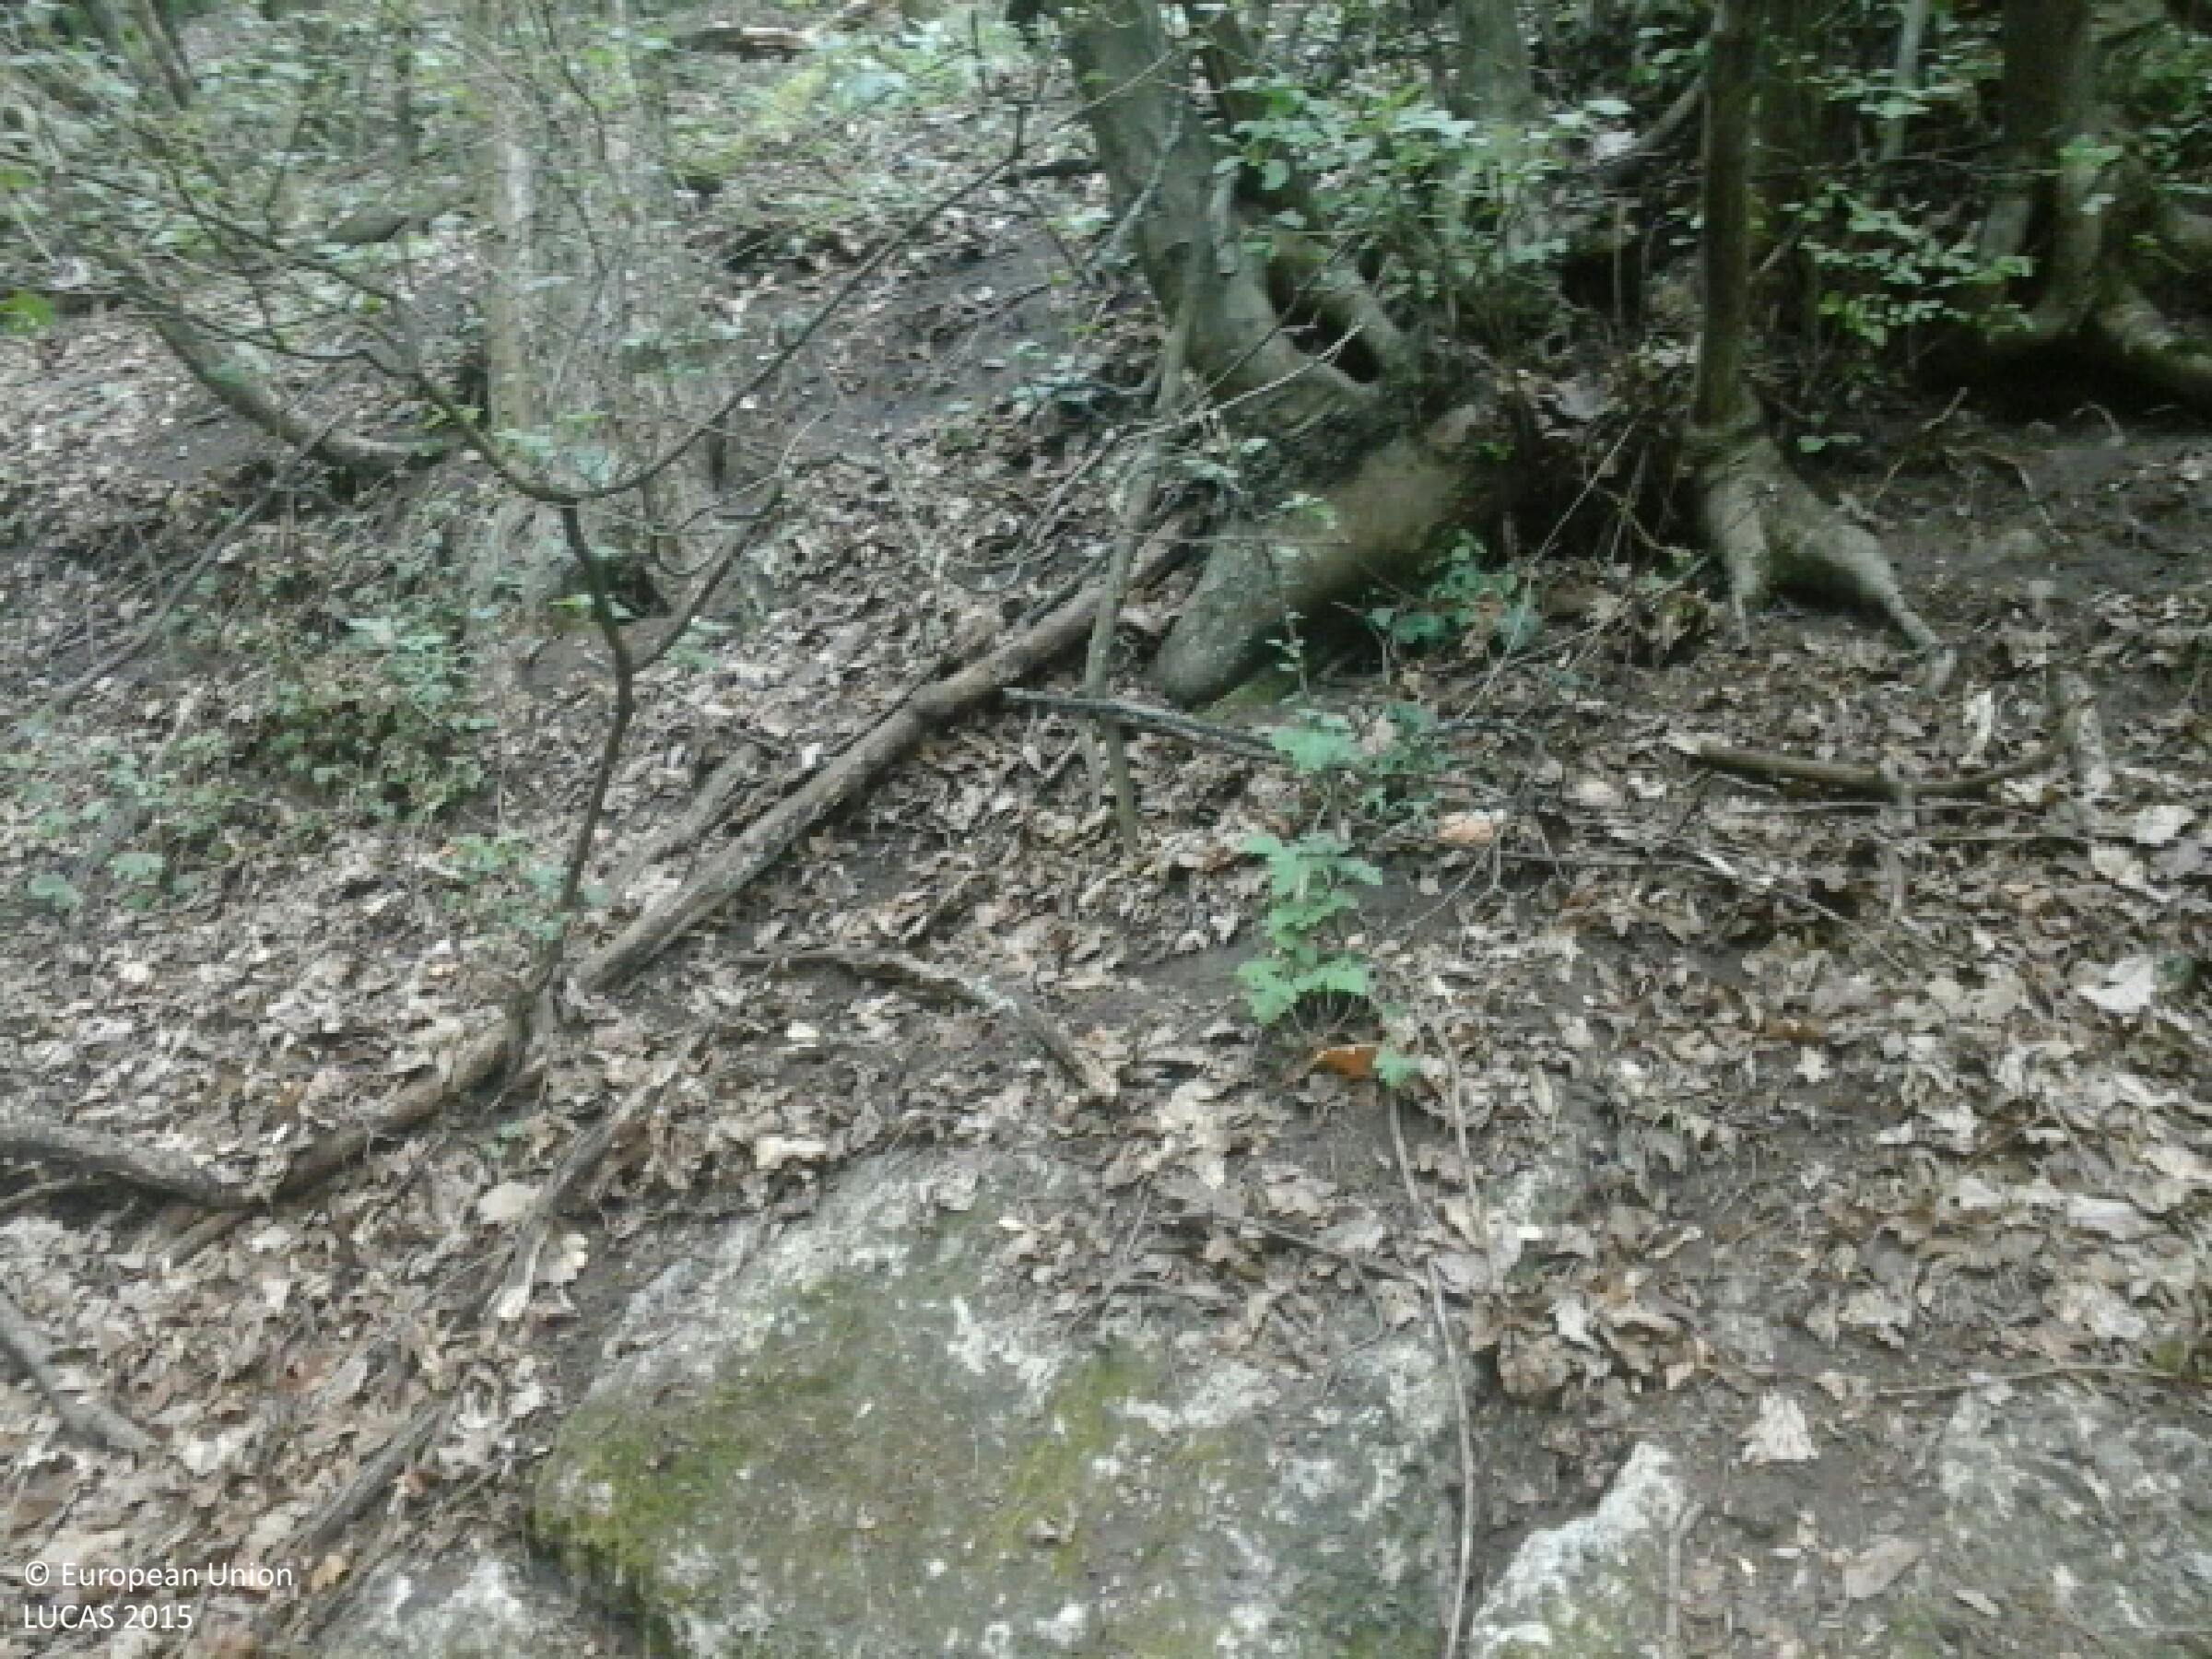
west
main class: Woodland
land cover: Broadleaved woodland
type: mesophytic deciduous forest
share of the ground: > 75 %
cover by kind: broadleaved forest trees 95 %, unconsolidated bare surface 5 %
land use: Forestry
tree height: > 5 m
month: June
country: HU
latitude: 47.7043
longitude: 19.0676
